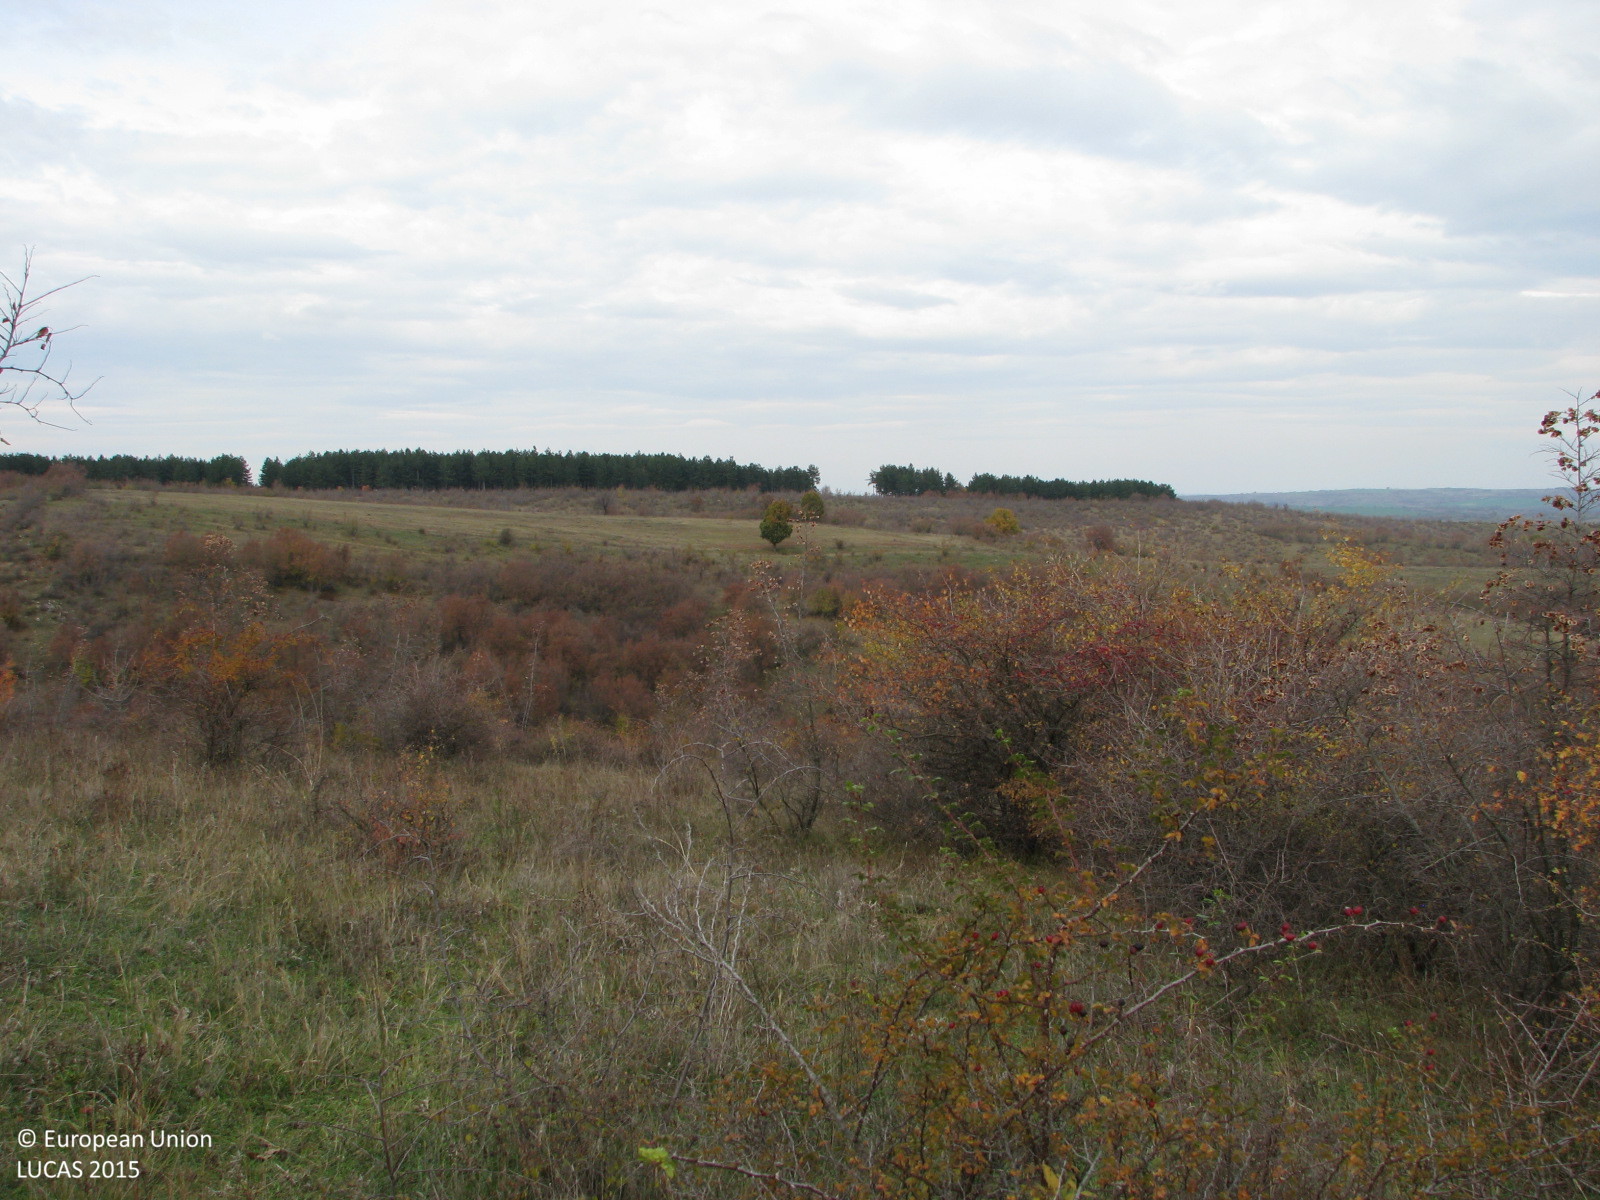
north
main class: Shrubland
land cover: Shrubland without tree cover
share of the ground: 50 - 75 %
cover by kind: shrubs 55 %, herbaceous plants 45 %
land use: Agriculture (excluding fallow land and kitchen gardens)
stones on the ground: < 10 %
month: November
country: BG
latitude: 41.9984
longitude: 26.4426
